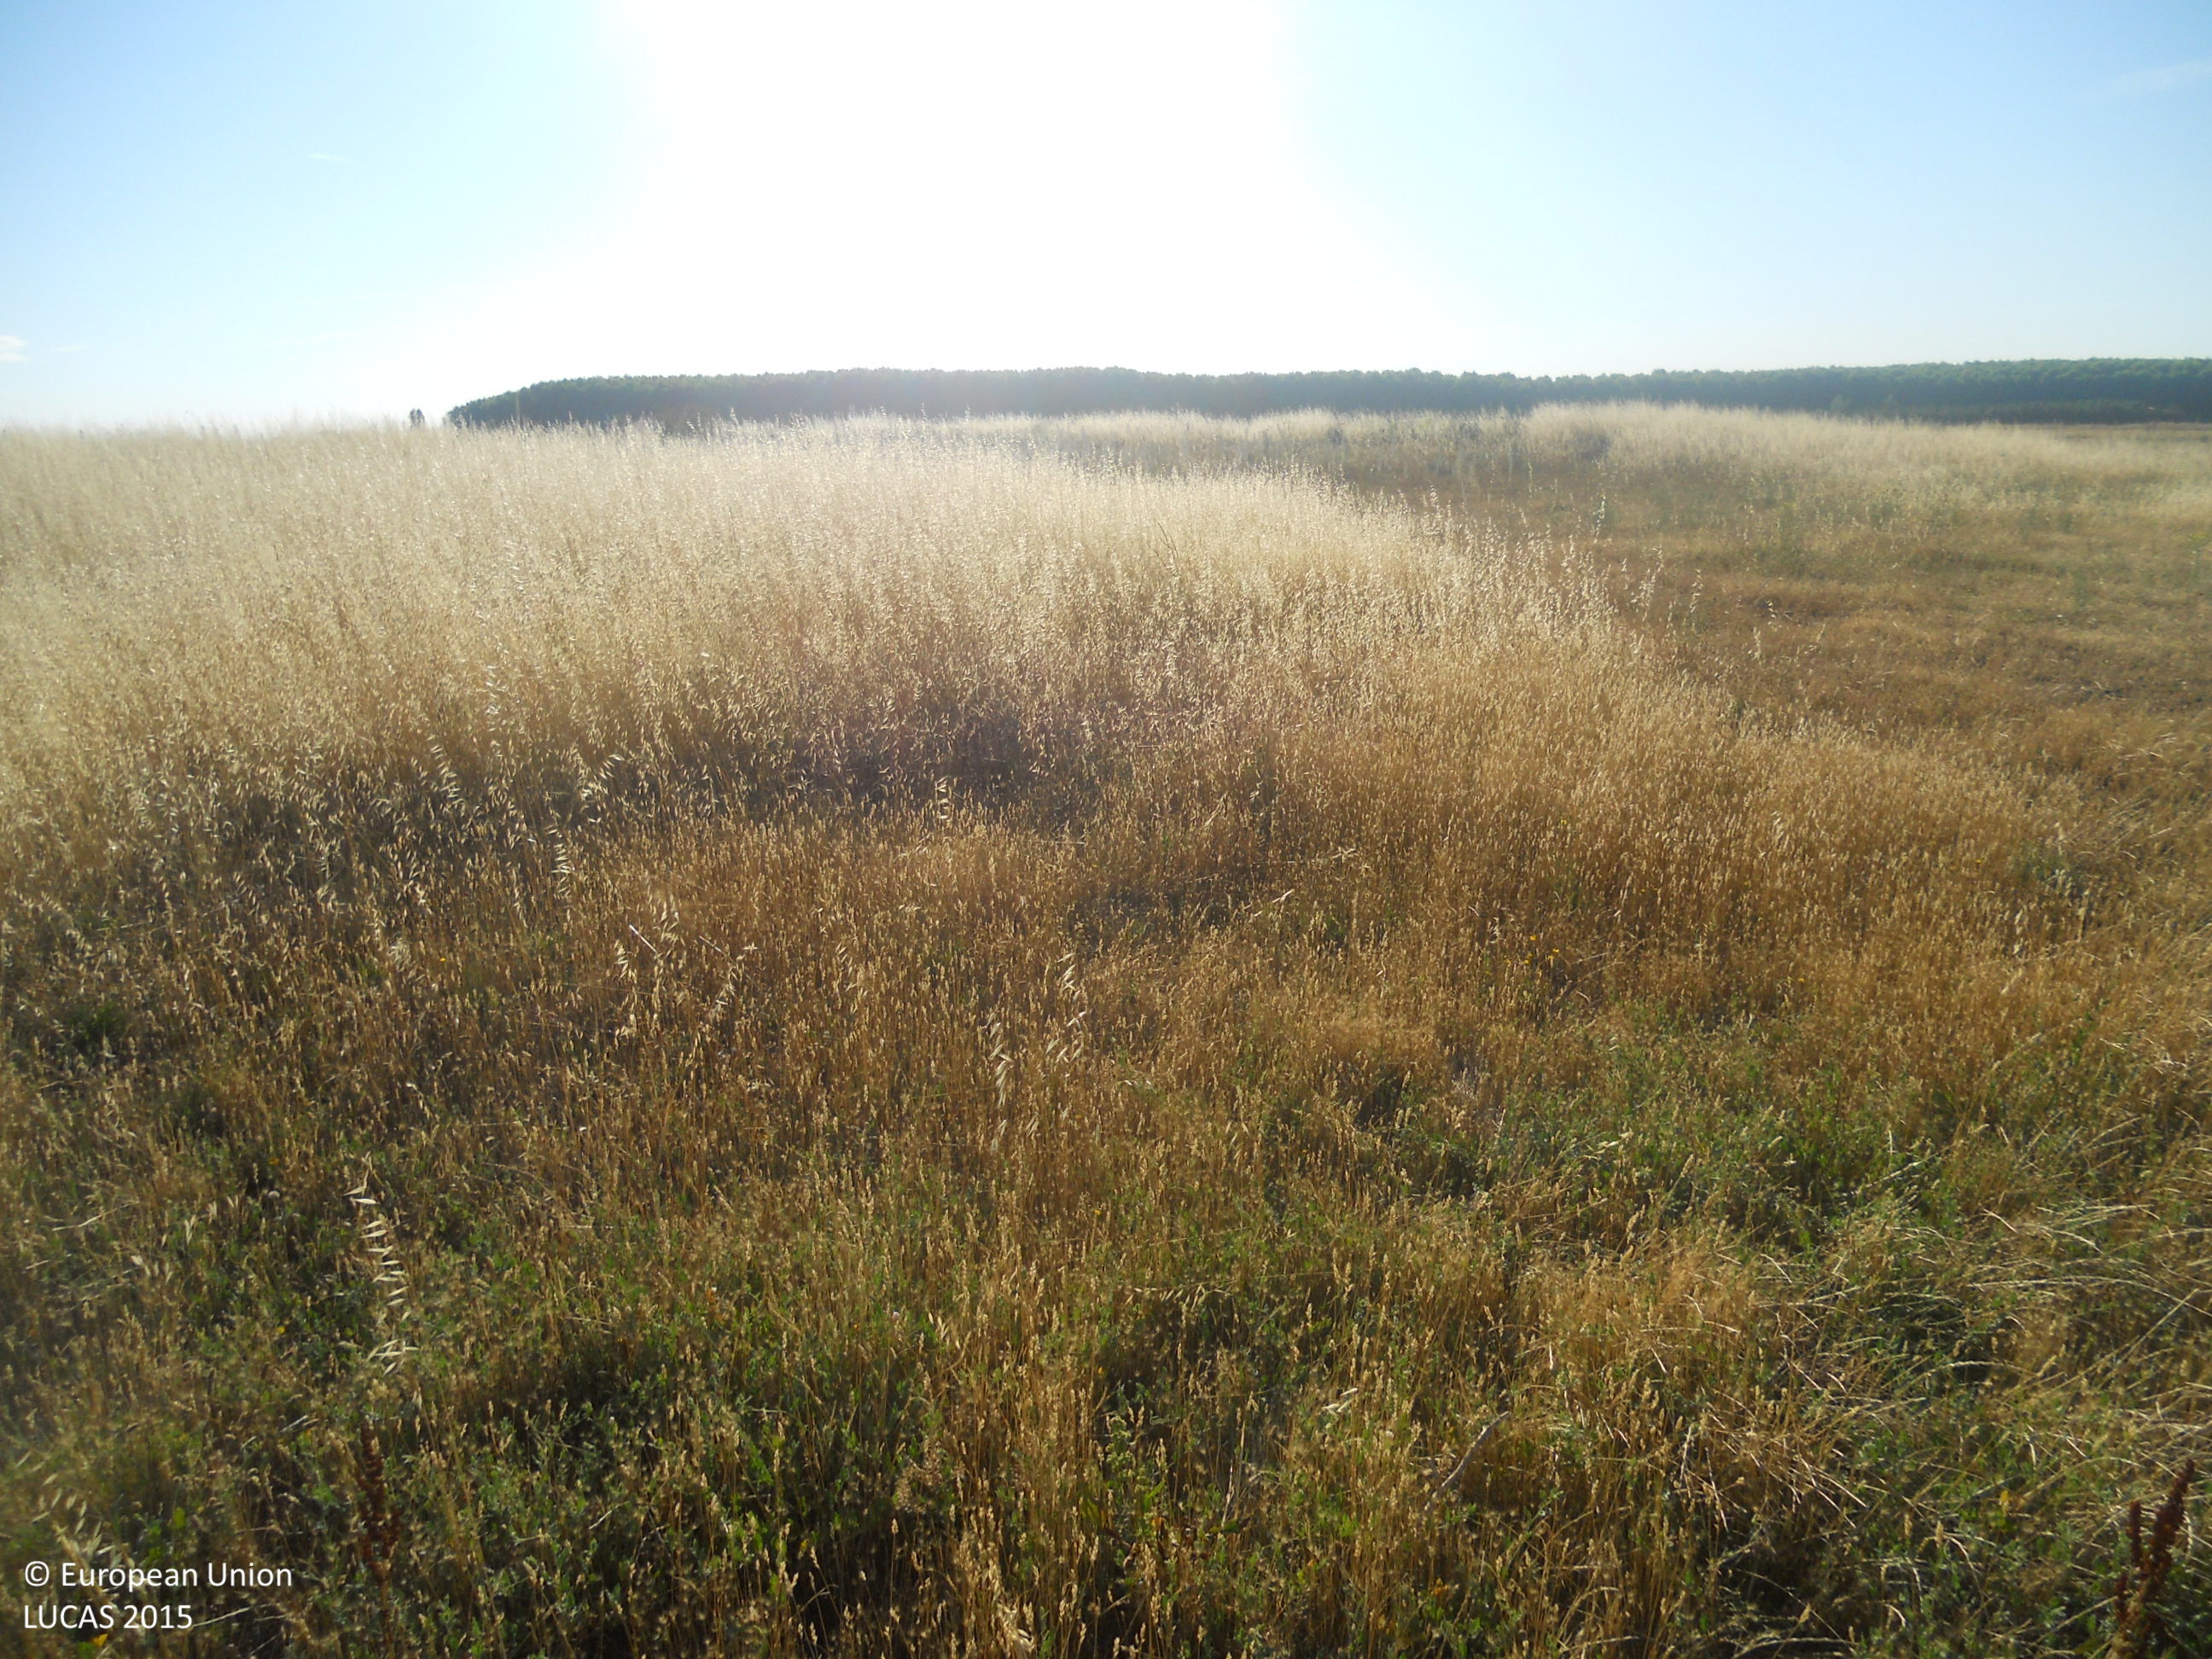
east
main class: Grassland
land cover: Grassland without tree/shrub cover
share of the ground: > 75 %
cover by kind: herbaceous plants 100 %
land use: Abandoned areas
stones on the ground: > 50 %
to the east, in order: Grassland without tree/shrub cover; Tracks; Grassland without tree/shrub cover; Other bare soil
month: July
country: ES
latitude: 42.4557
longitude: -5.3020
